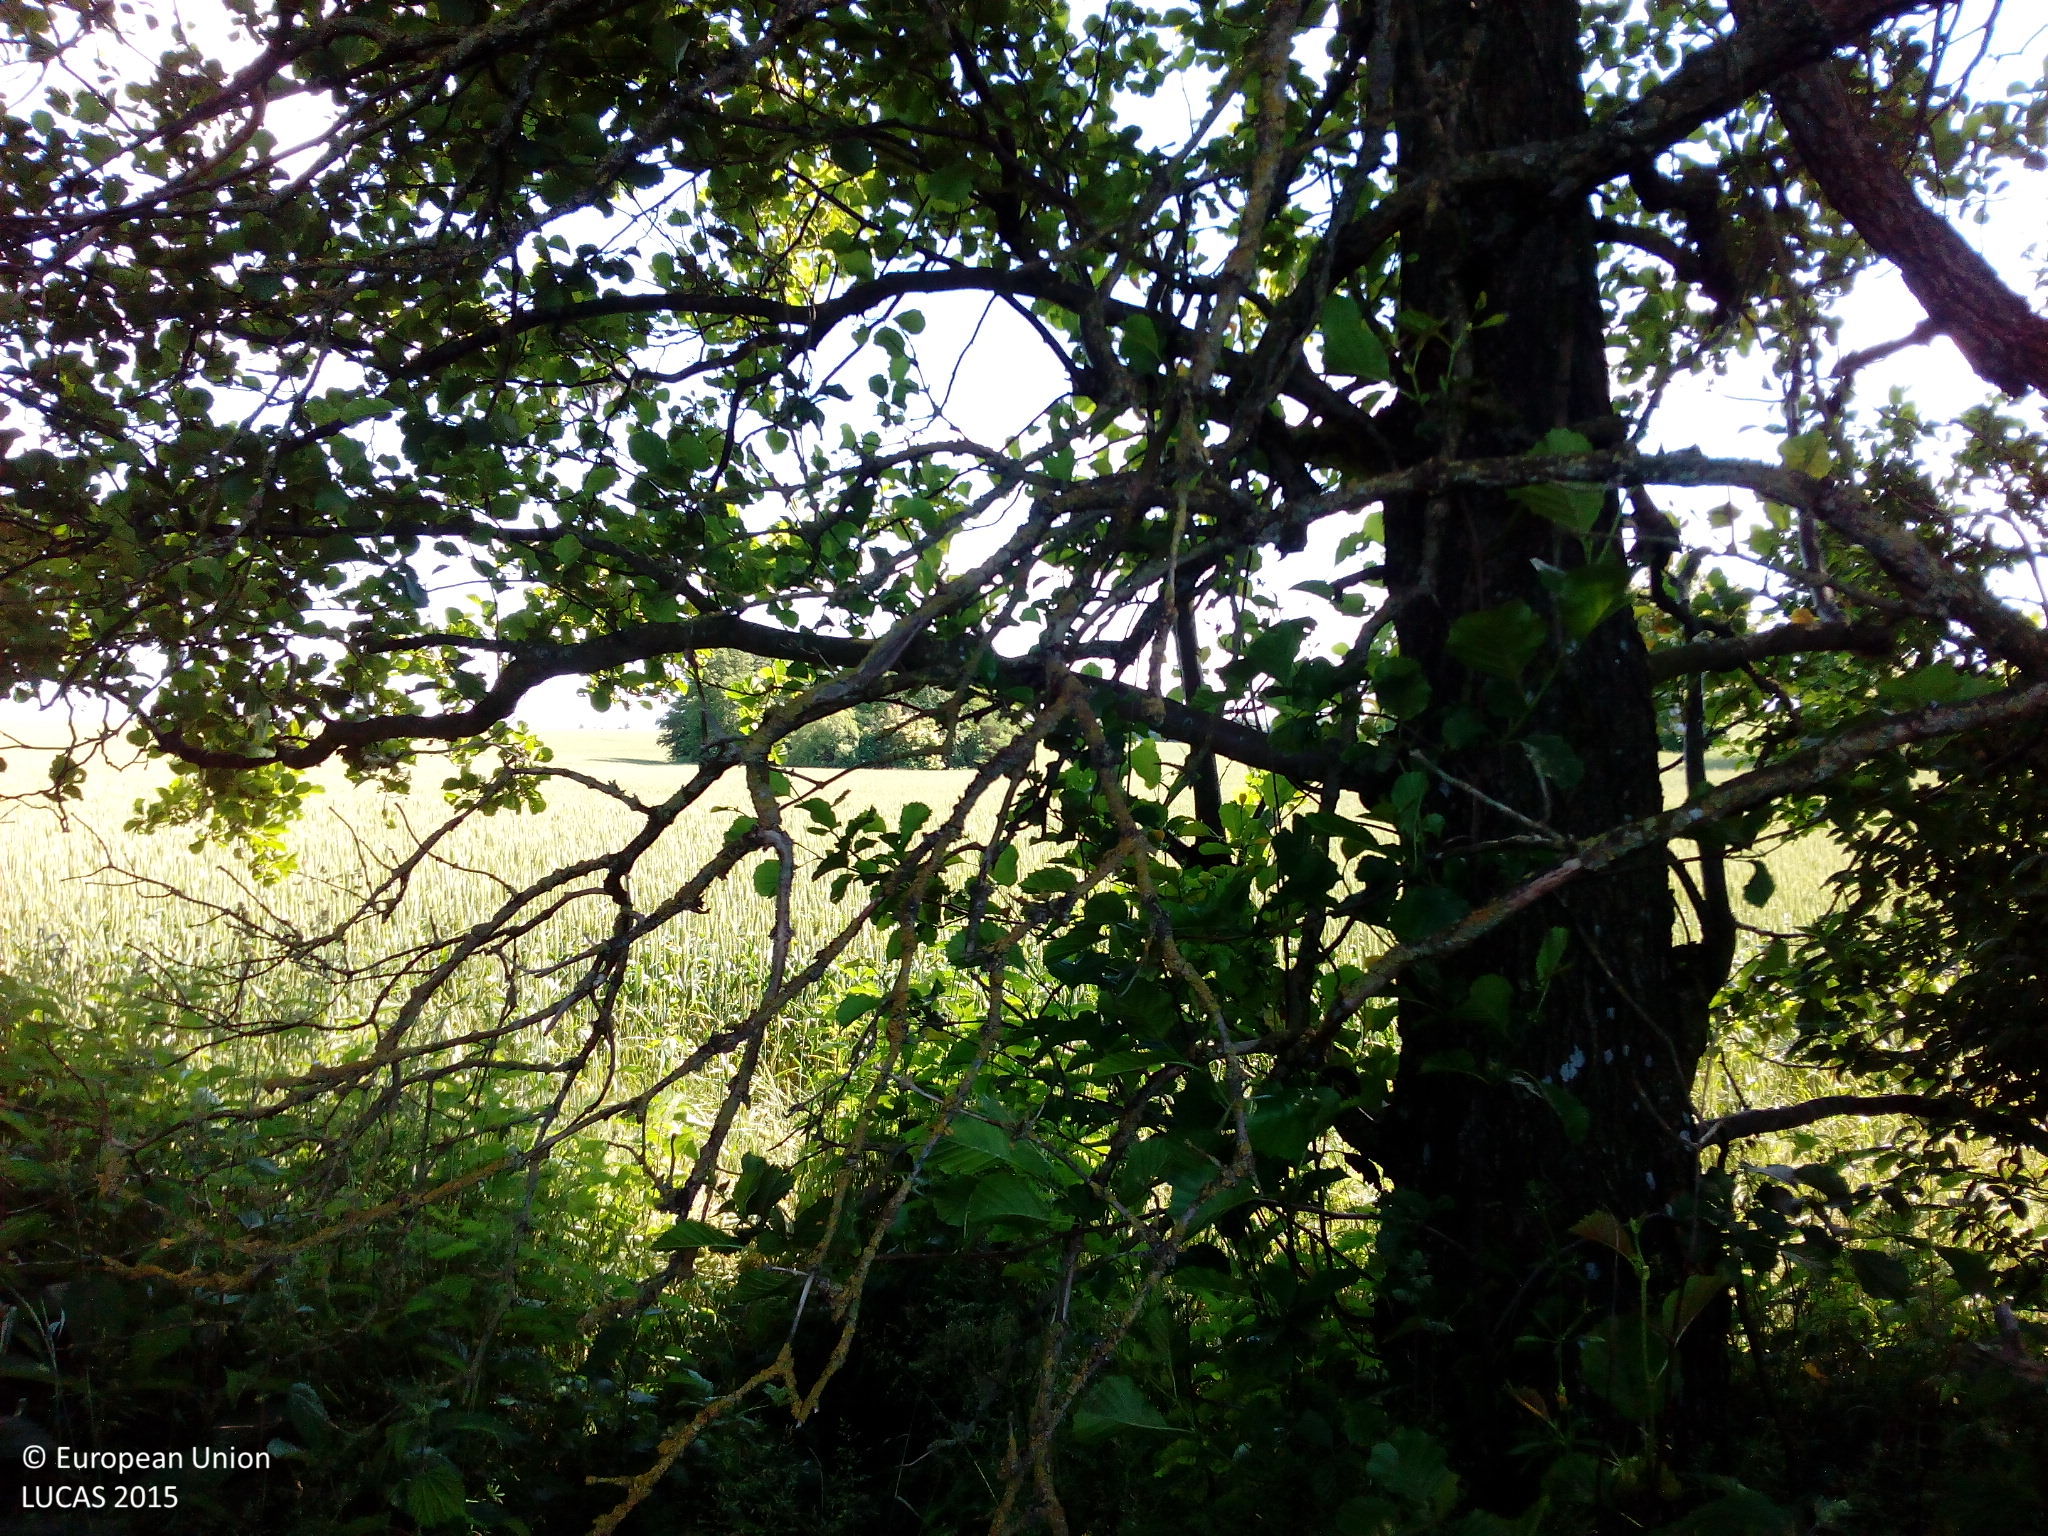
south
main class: Woodland
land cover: Broadleaved woodland
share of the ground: 50 - 75 %
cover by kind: broadleaved forest trees 55 %, herbaceous plants 35 %, shrubs 10 %
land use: Semi-natural and natural areas not in use
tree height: > 5 m
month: June
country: DK
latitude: 56.3113
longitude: 10.7588
